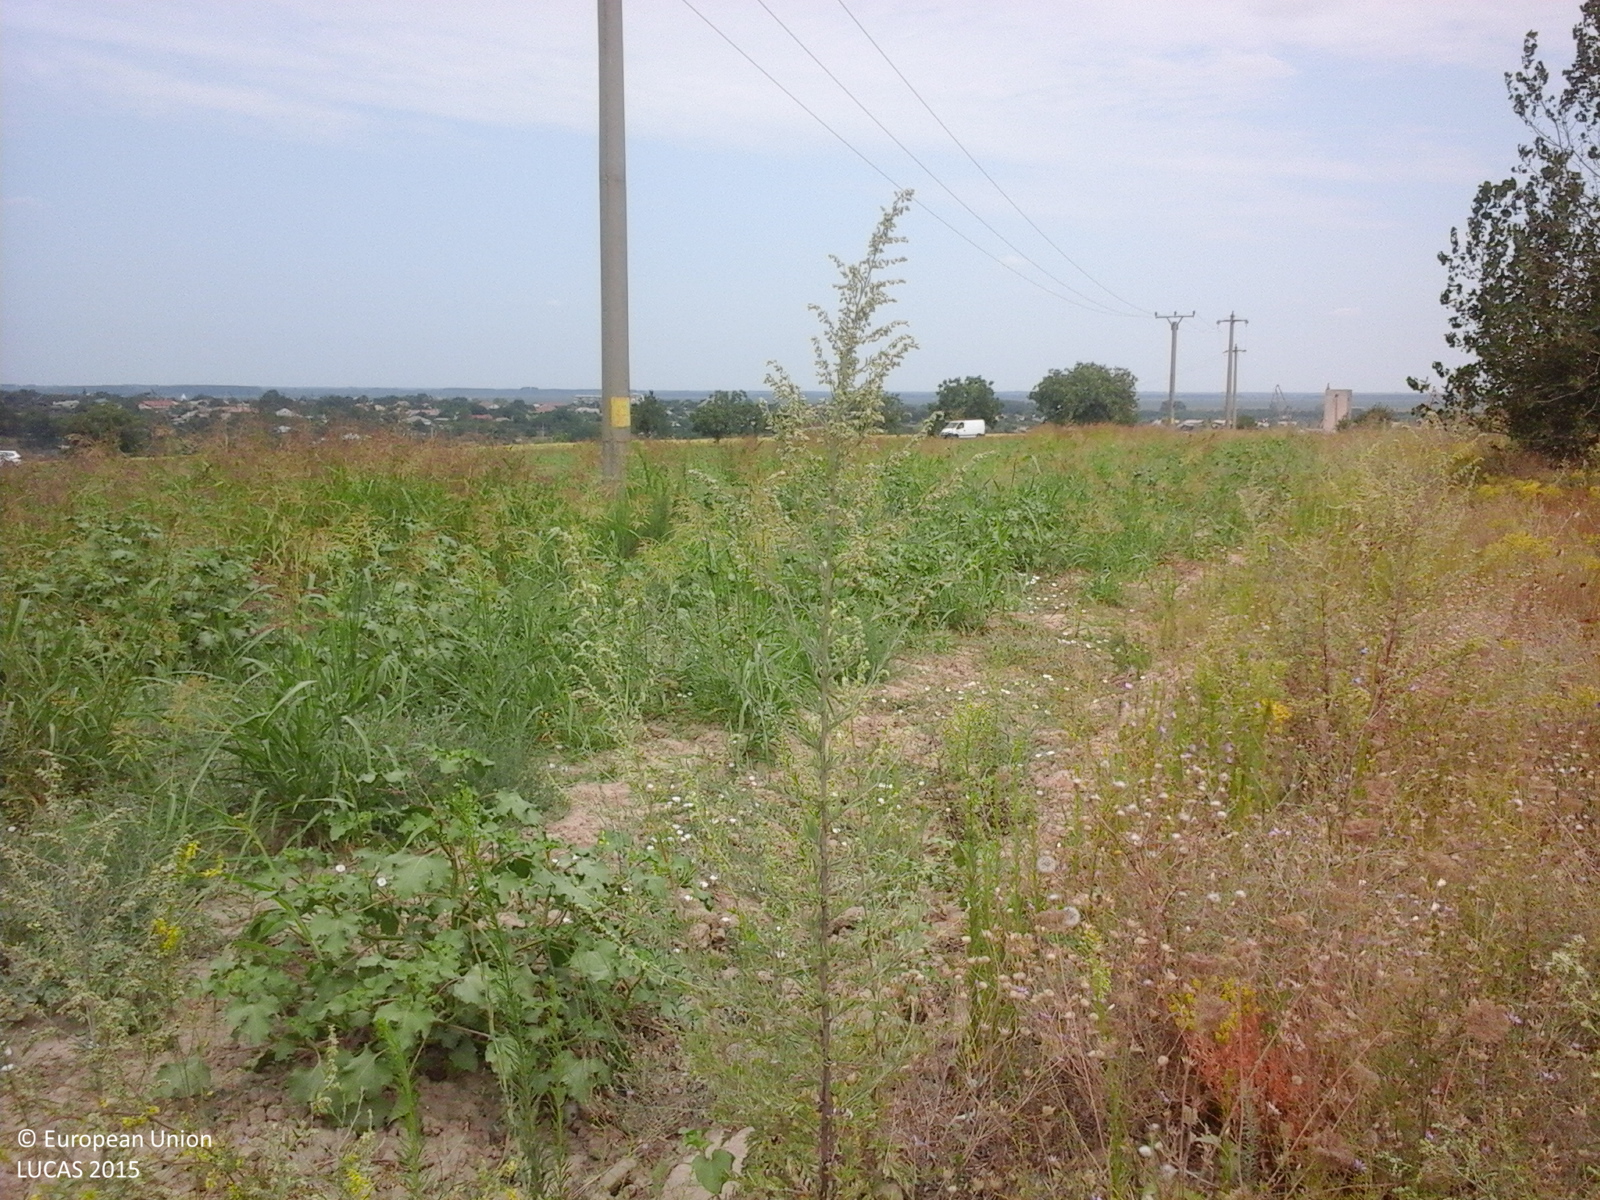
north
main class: Grassland
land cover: Spontaneously vegetated surfaces
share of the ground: > 75 %
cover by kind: herbaceous plants 100 %
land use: Fallow land
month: August
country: RO
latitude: 45.0733
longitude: 29.0886
